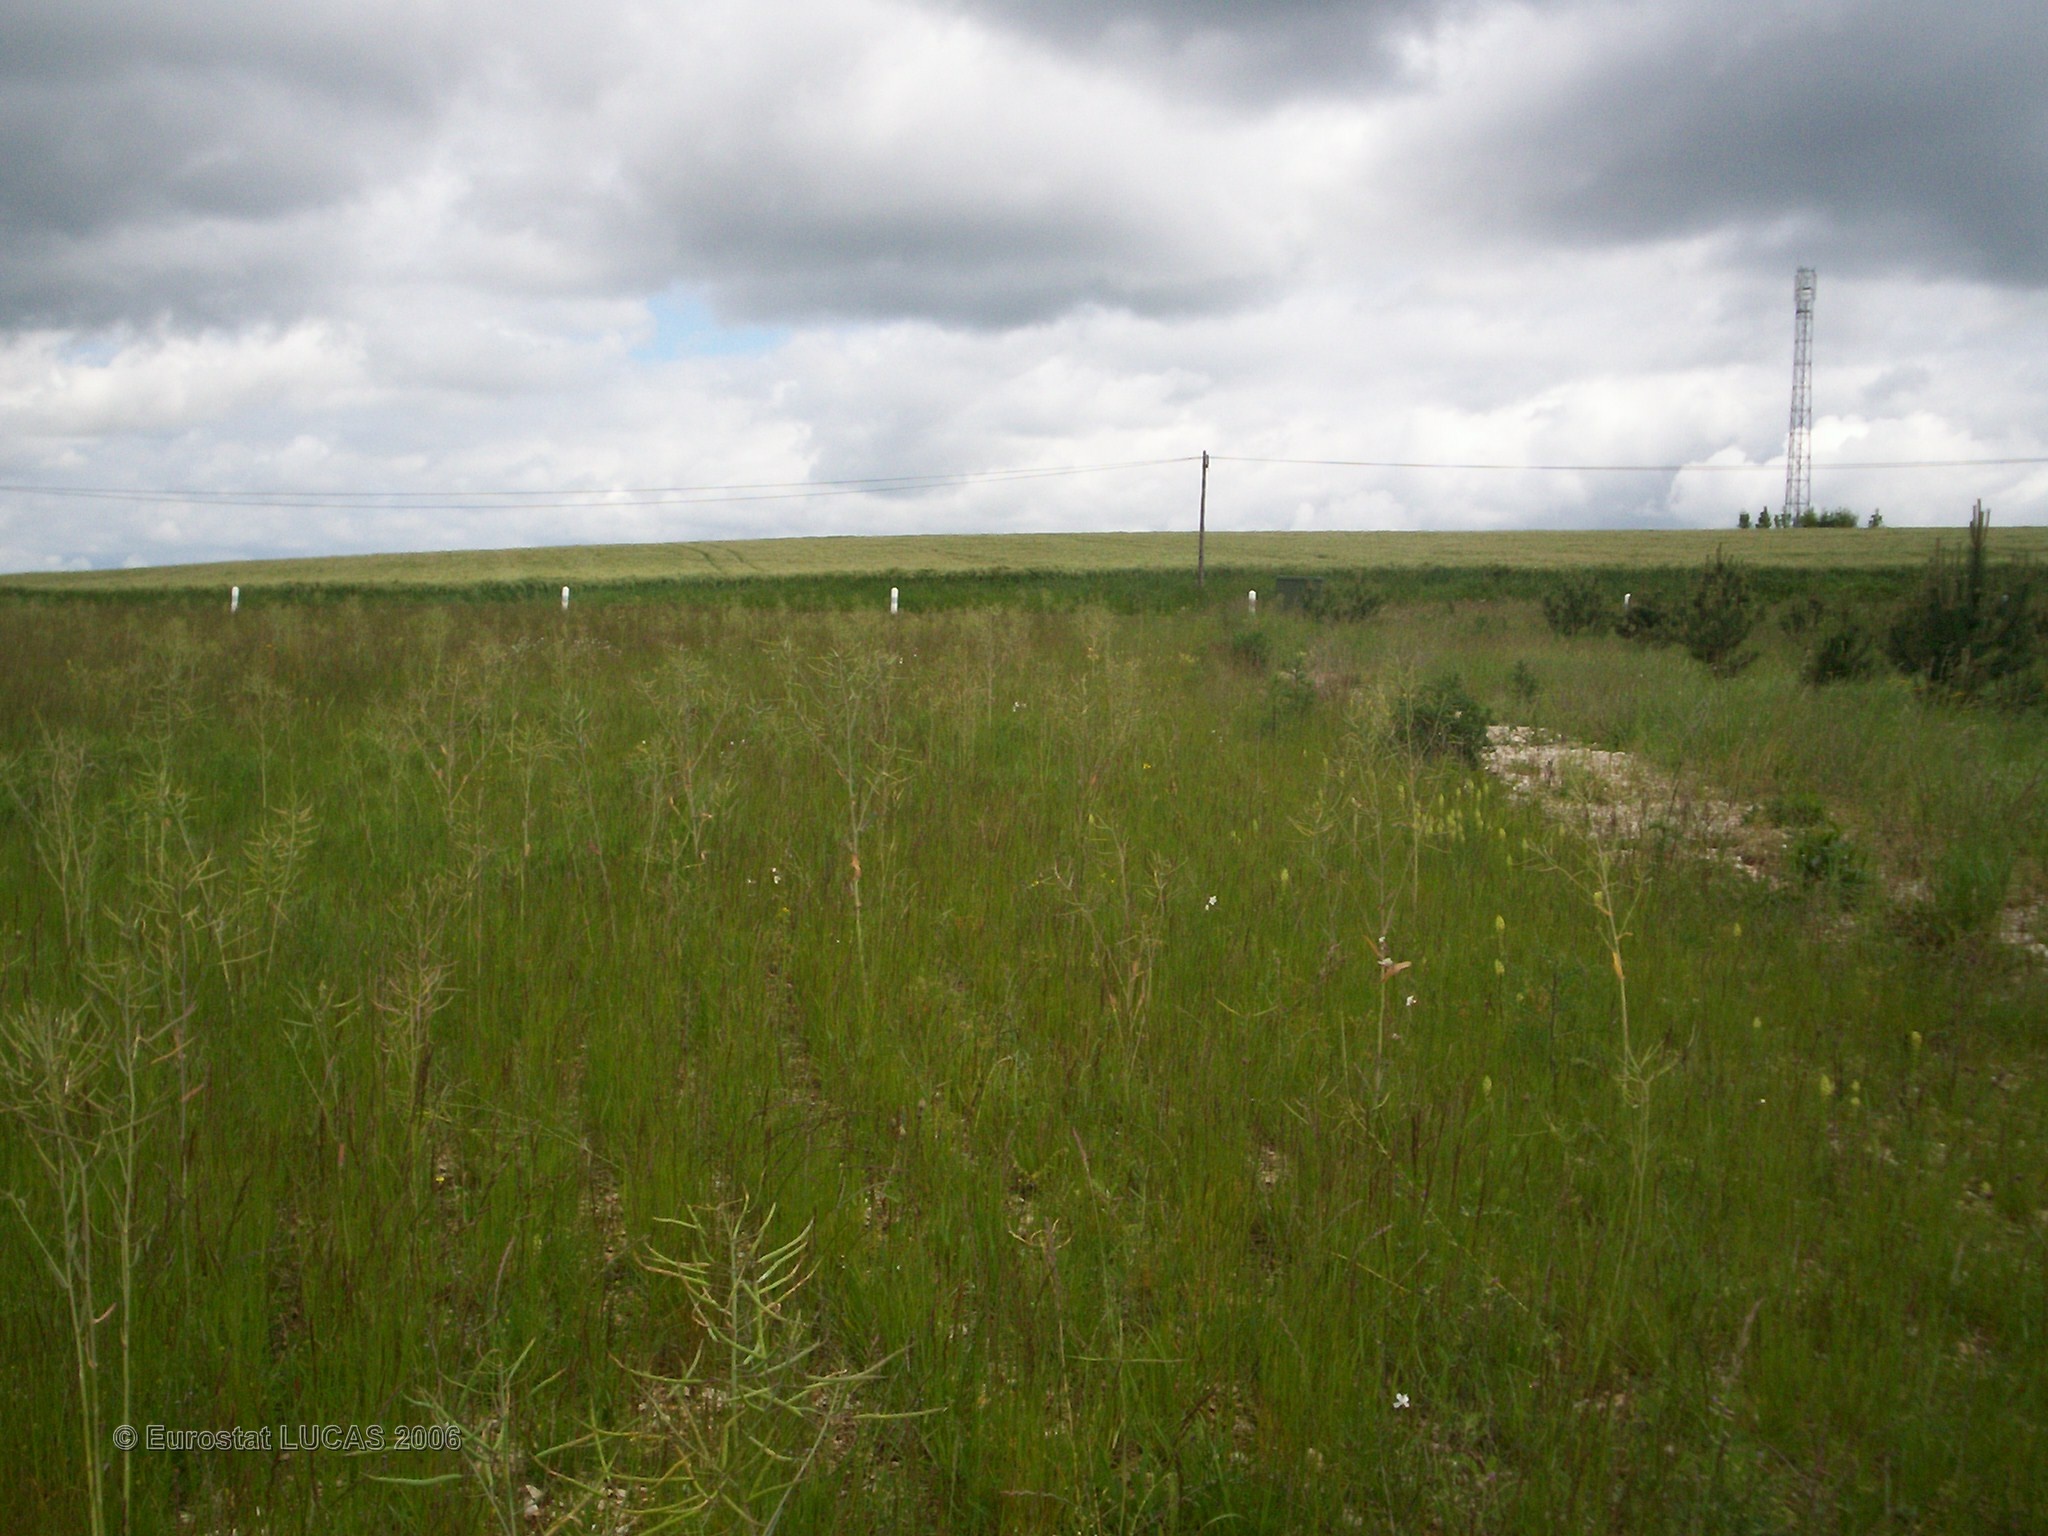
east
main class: Grassland
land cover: Grassland without tree/shrub cover
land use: Agriculture (excluding fallow land and kitchen gardens)
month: May
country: FR
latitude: 47.6015
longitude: 3.8655
